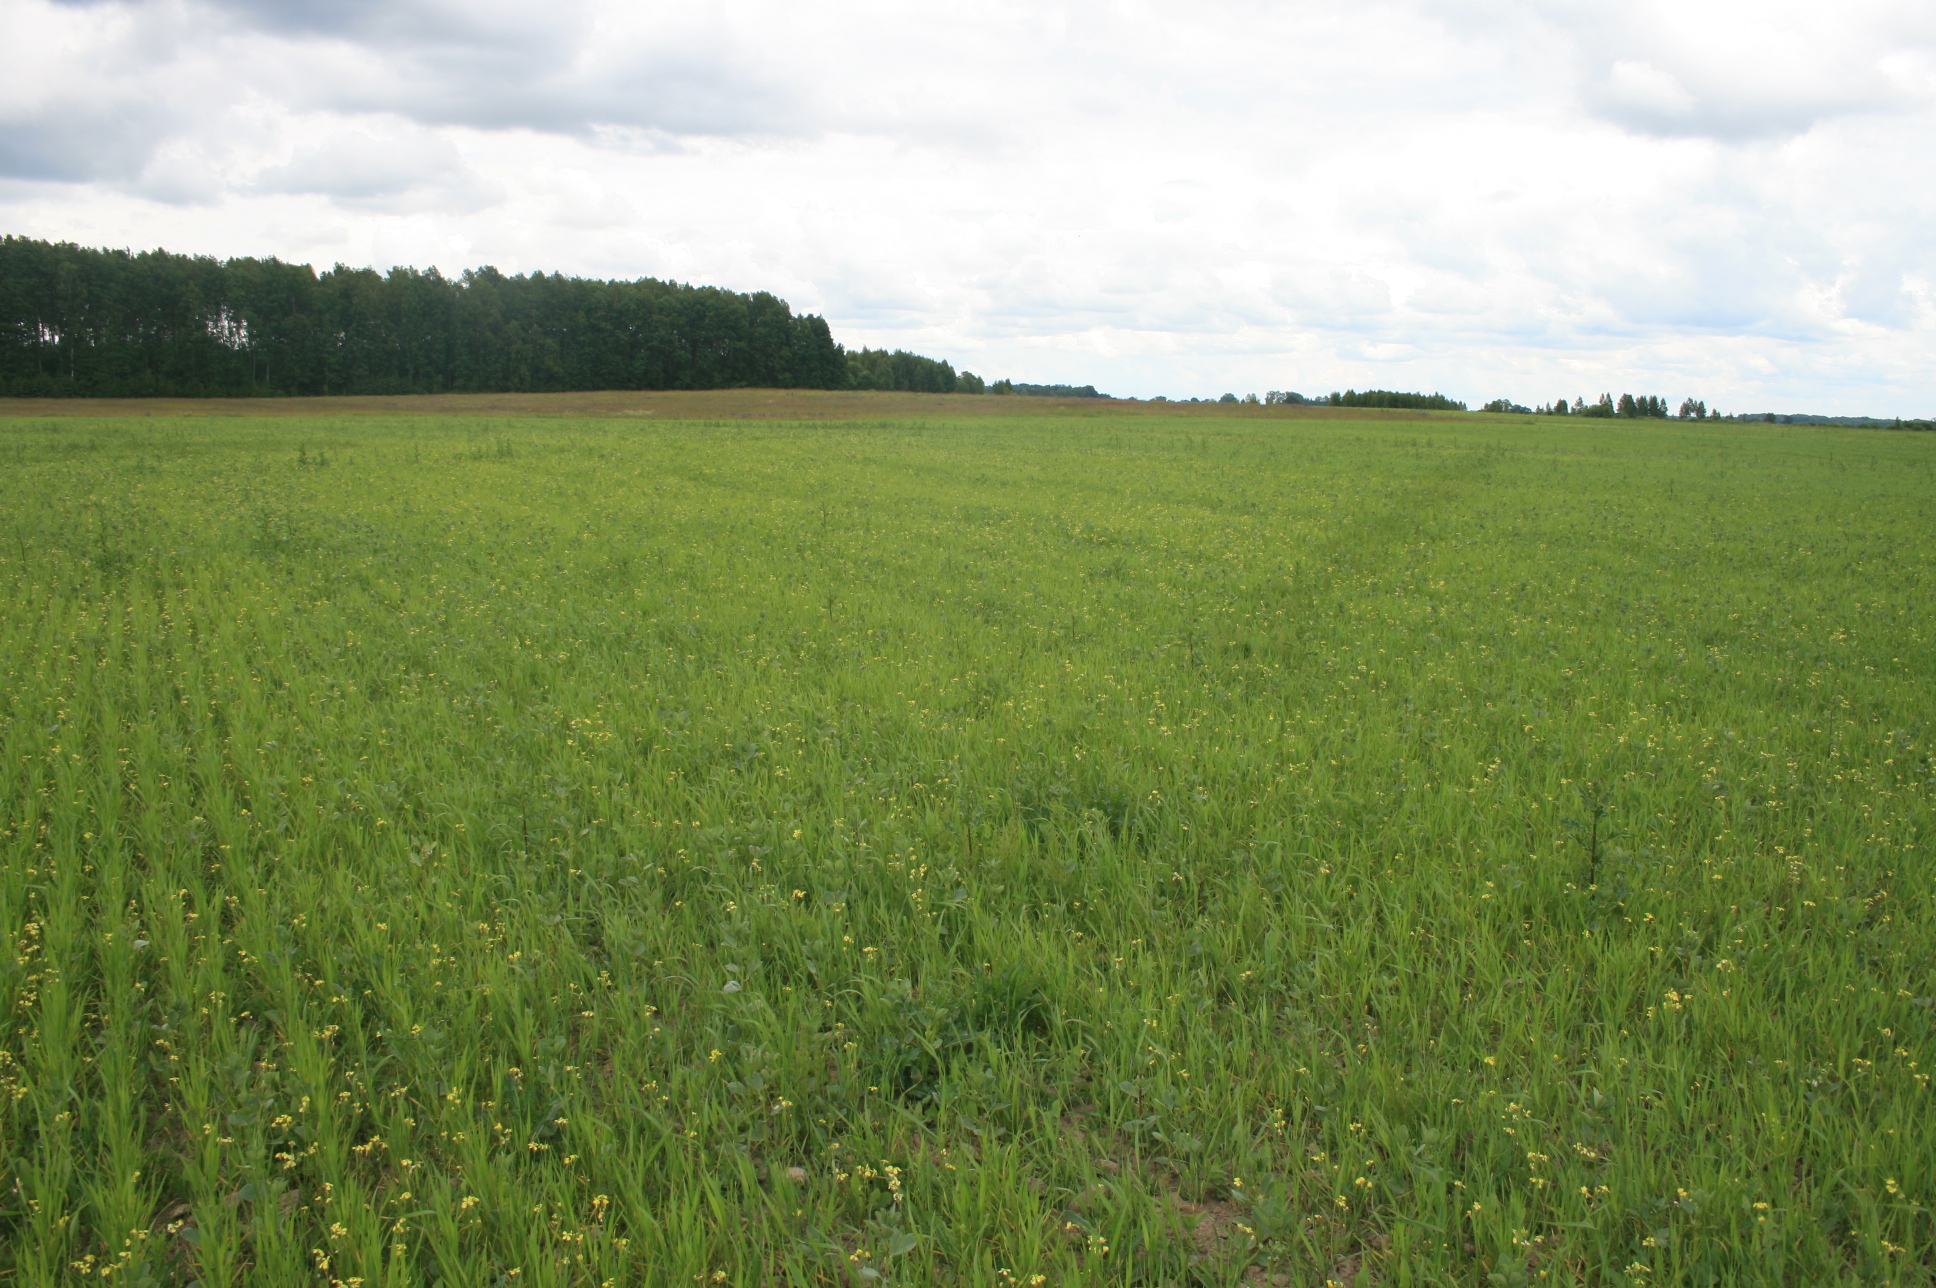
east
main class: Cropland
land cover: Other leguminous and mixtures for fodder
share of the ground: > 75 %
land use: Agriculture (excluding fallow land and kitchen gardens)
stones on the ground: < 10 %
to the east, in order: Other leguminous and mixtures for fodder; Grassland without tree/shrub cover
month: June
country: LT
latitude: 55.3905
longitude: 22.3249
